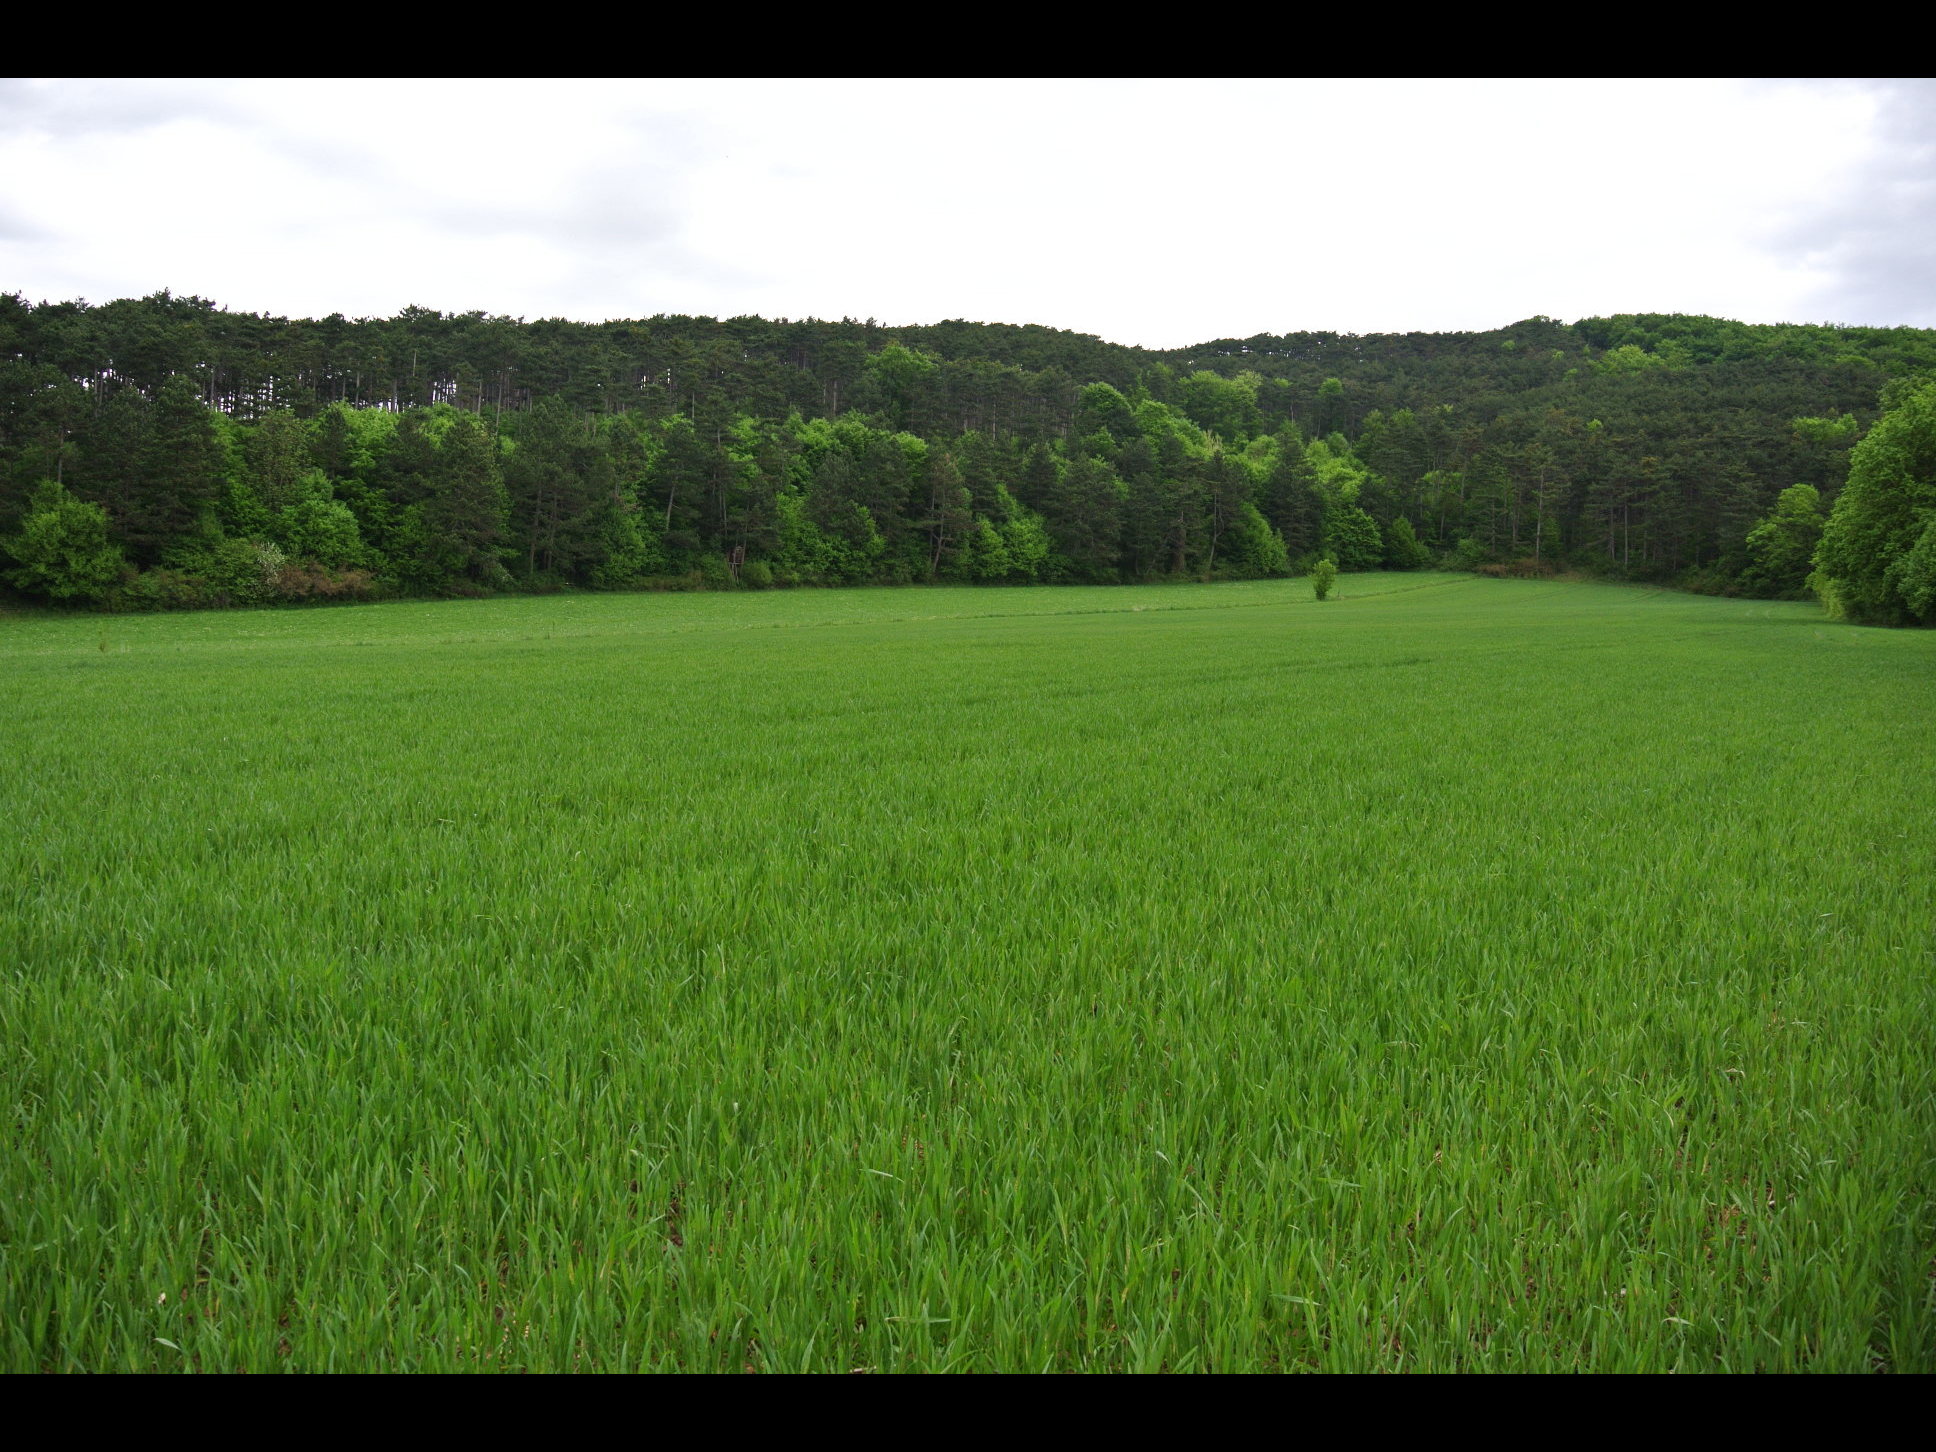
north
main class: Cropland
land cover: Barley
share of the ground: > 75 %
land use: Agriculture (excluding fallow land and kitchen gardens)
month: May
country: AT
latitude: 47.9645
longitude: 16.0976
